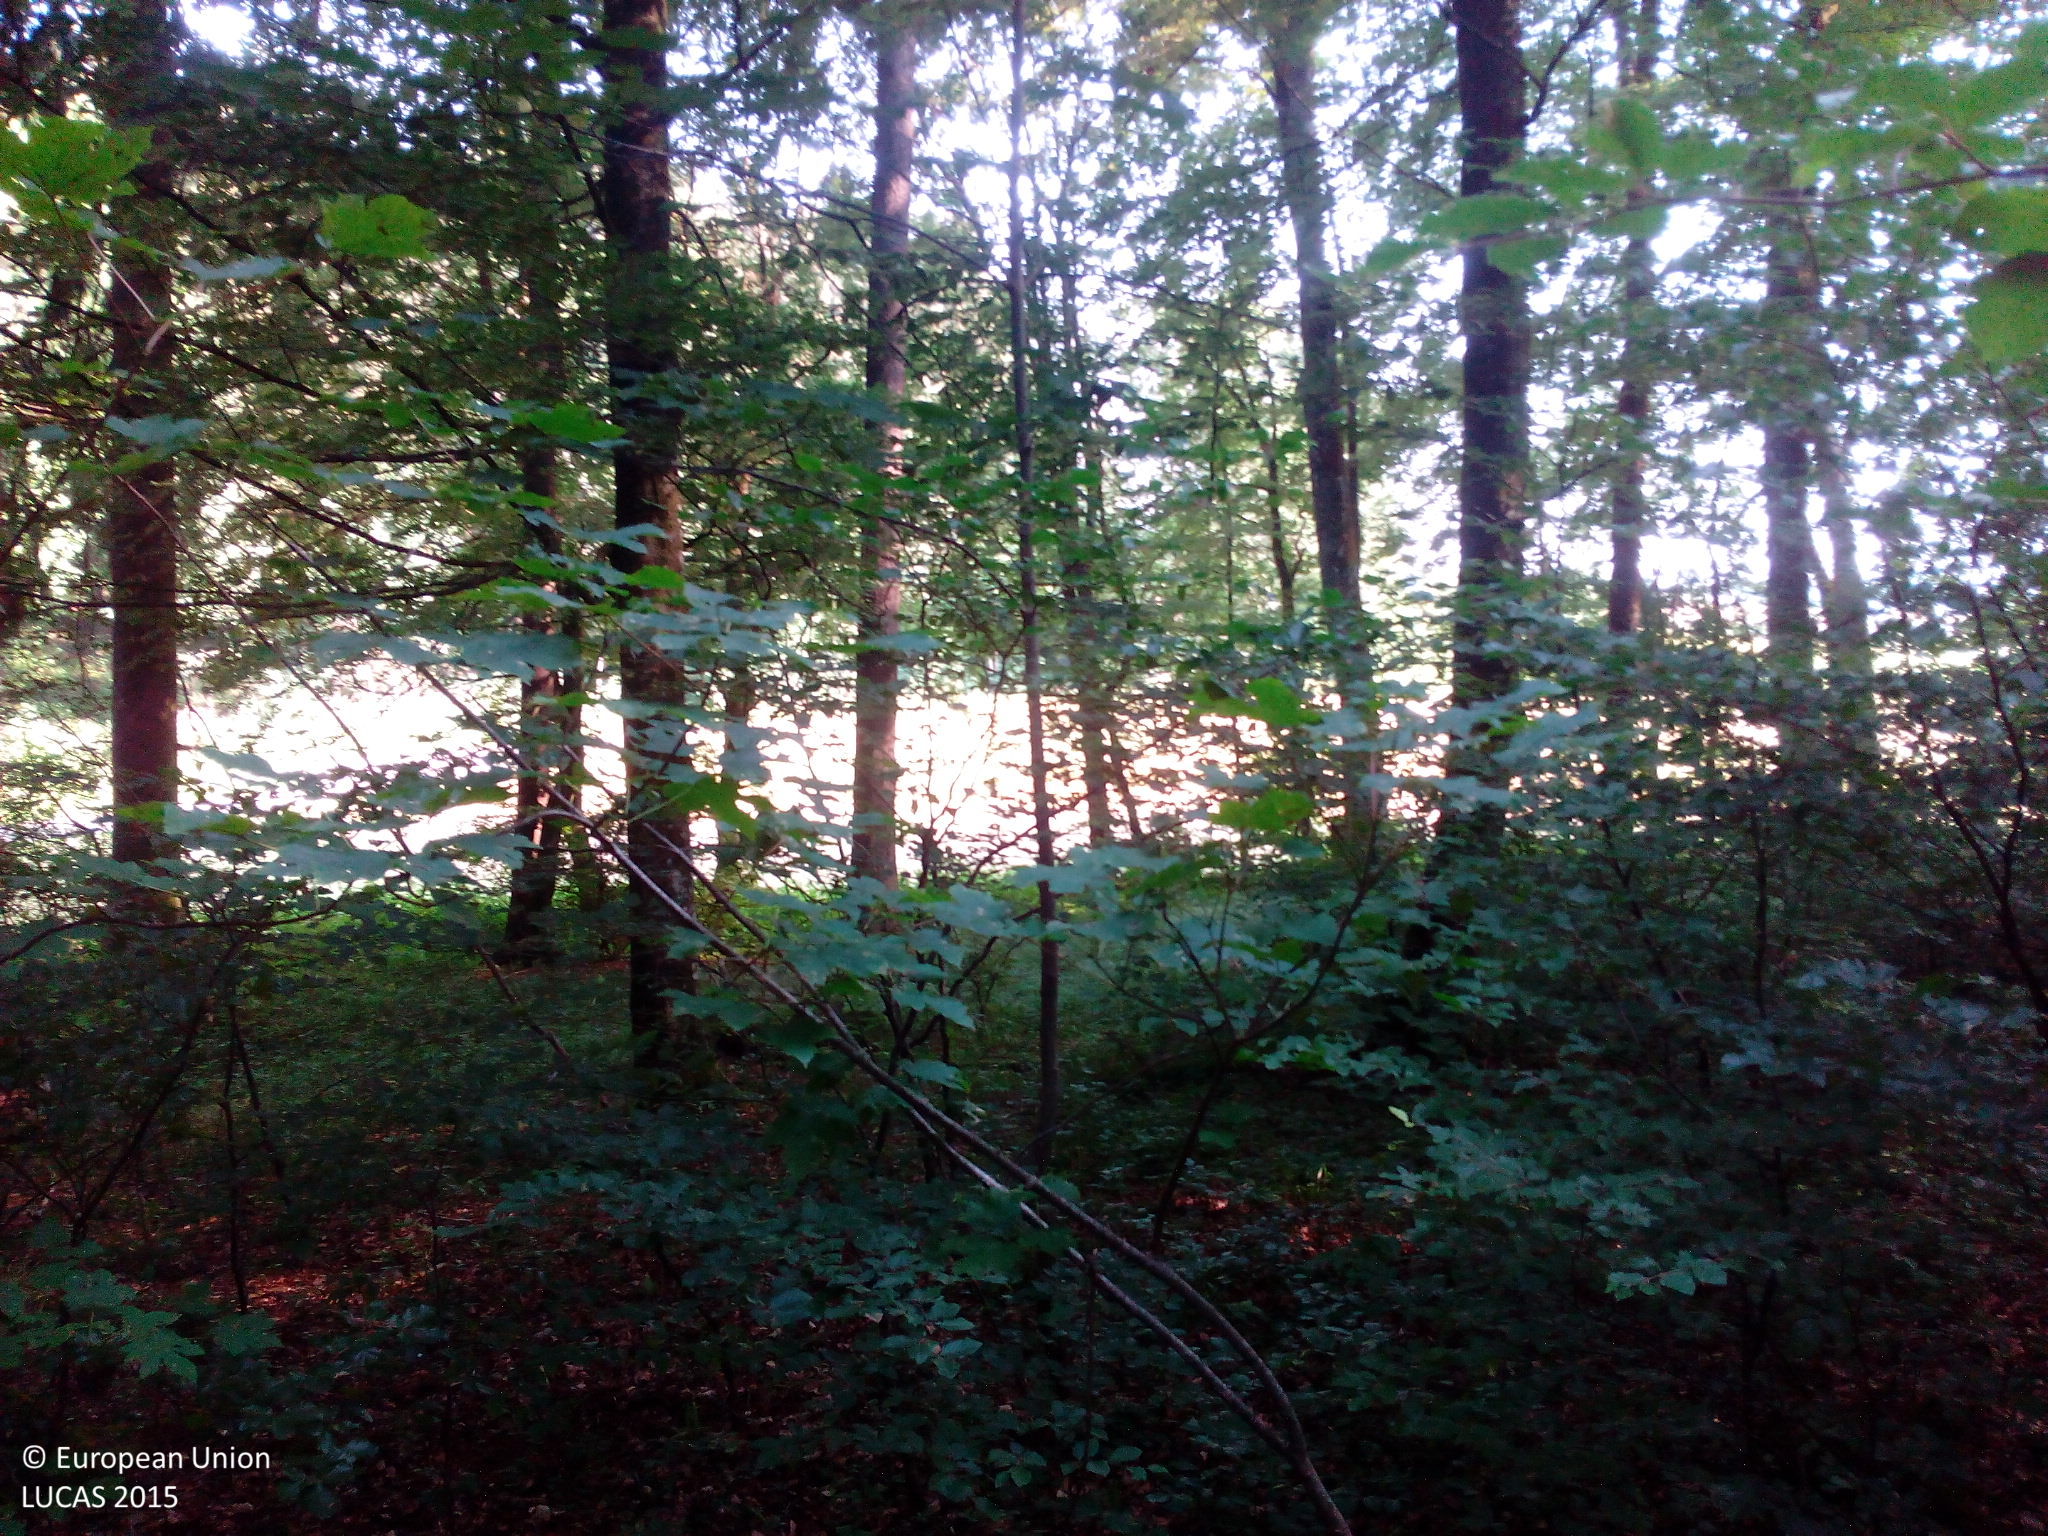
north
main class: Woodland
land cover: Broadleaved woodland
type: mesophytic deciduous forest
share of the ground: > 75 %
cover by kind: broadleaved forest trees 95 %, unconsolidated bare surface 5 %
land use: Forestry
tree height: > 5 m
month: July
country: DE
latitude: 48.1494
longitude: 9.3149
